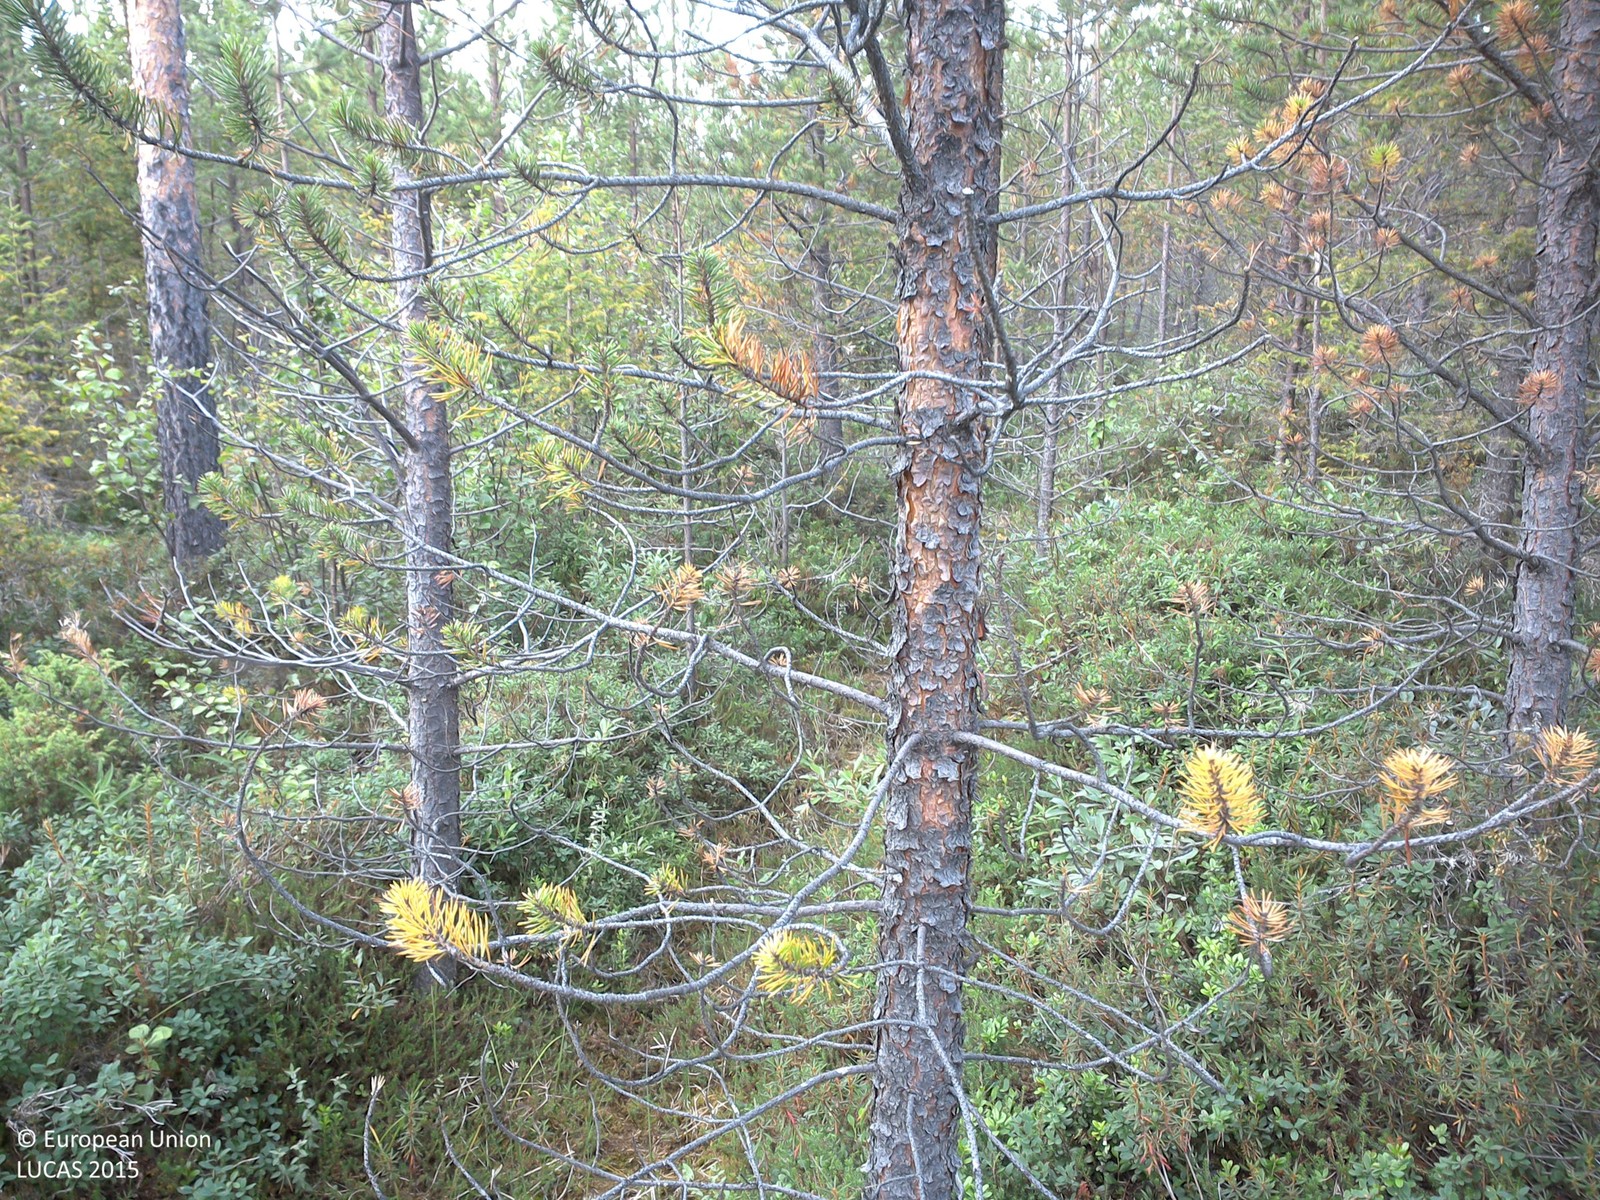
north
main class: Woodland
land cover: Pine dominated coniferous woodland
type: boreal forest
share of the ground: 25 - 50 %
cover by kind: shrubs 55 %, coniferous forest trees 30 %, lichens and mosses 10 %, broadleaved forest trees 5 %
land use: Forestry
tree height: < 5 m
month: August
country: SE
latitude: 67.8691
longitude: 20.5248
